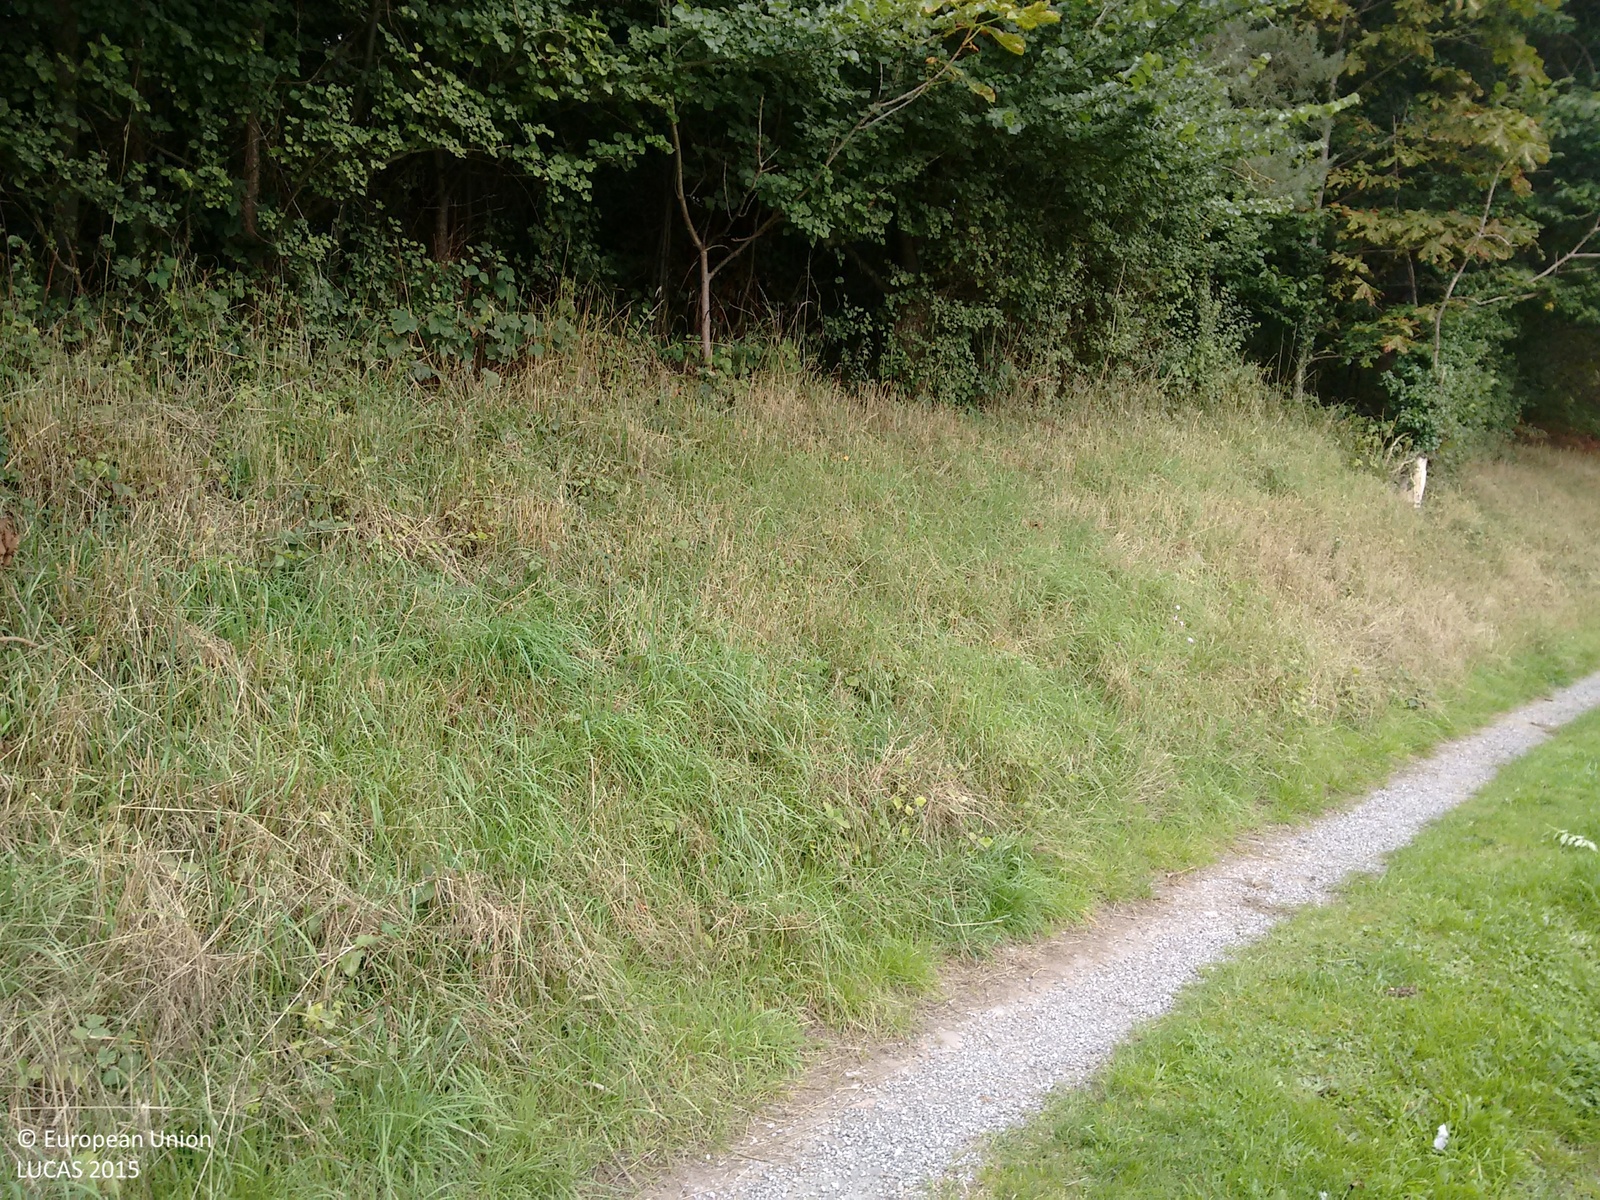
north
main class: Grassland
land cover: Grassland without tree/shrub cover
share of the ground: > 75 %
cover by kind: herbaceous plants 100 %
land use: Agriculture (excluding fallow land and kitchen gardens)
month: September
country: GB
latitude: 52.7990
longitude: -2.9025
